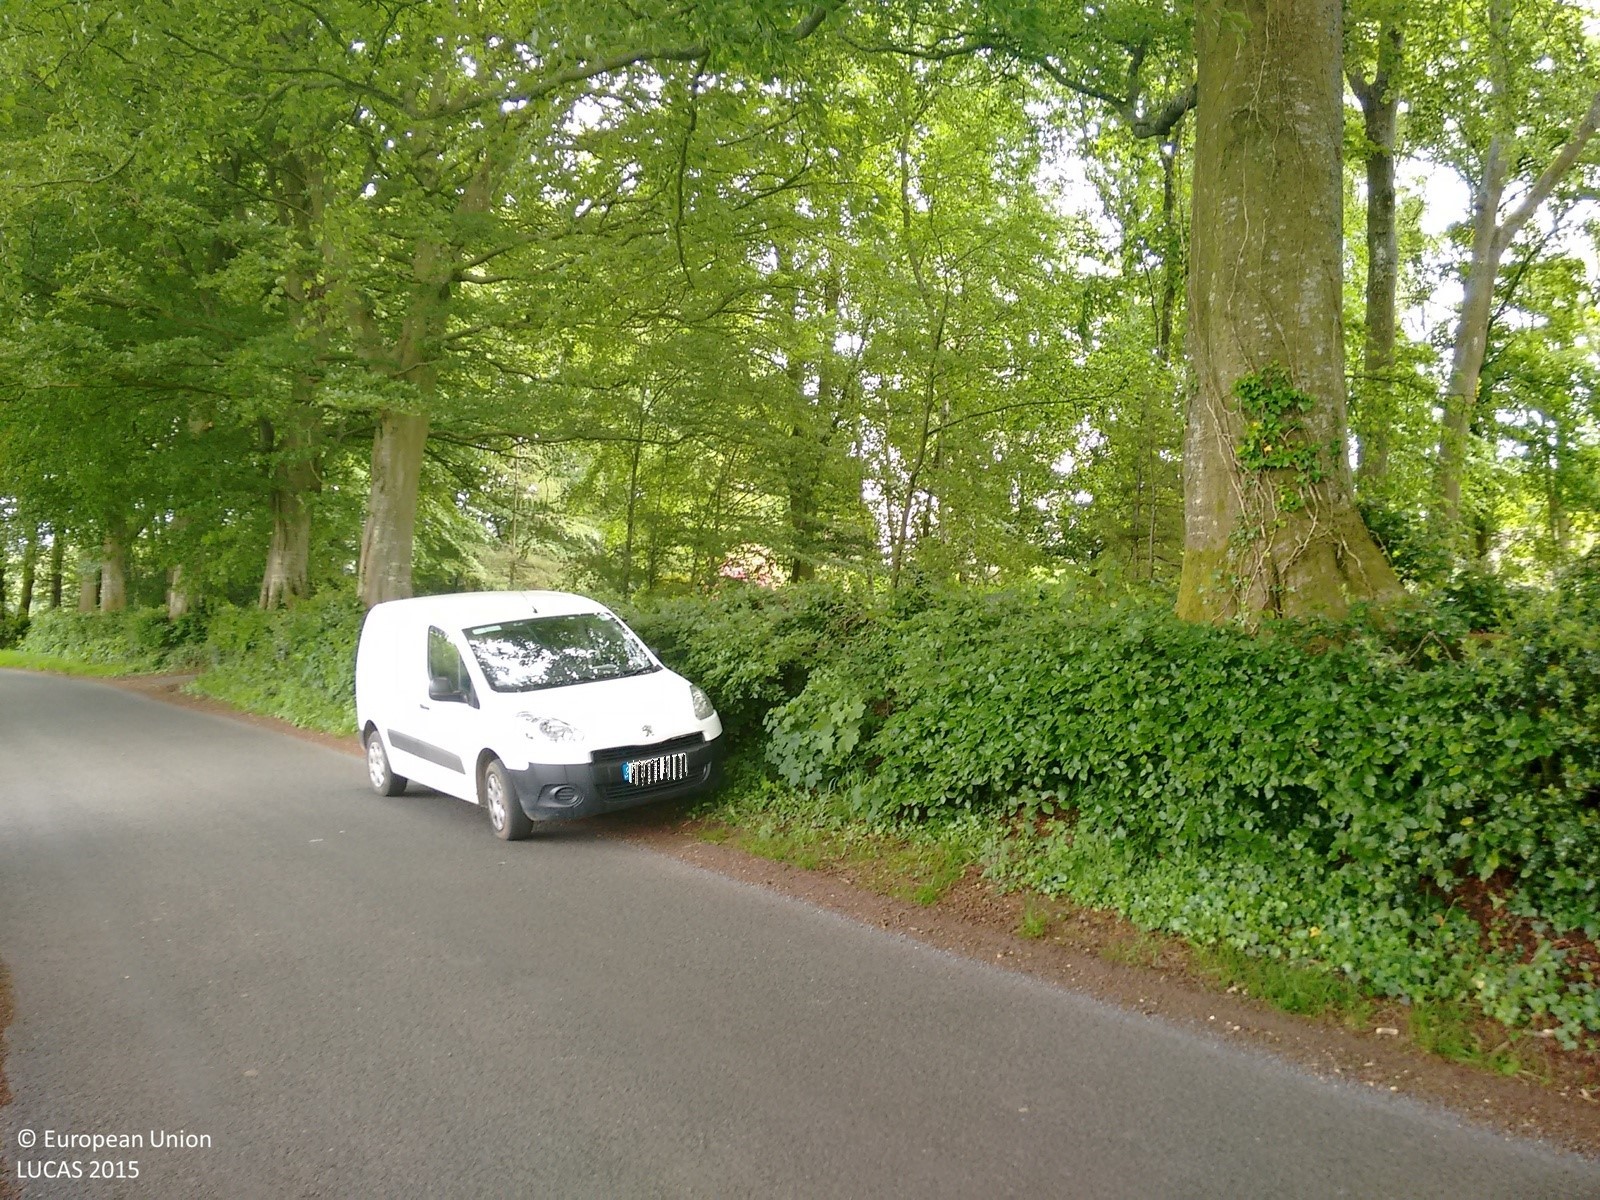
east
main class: Woodland
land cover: Broadleaved woodland
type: beech forest
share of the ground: > 75 %
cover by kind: broadleaved forest trees 90 %, herbaceous plants 10 %
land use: Semi-natural and natural areas not in use
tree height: > 5 m
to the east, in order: Broadleaved woodland; Managed hedges; Paved roads, cycling and walking lanes; Grass margins; Broadleaved woodland; Fences; Broadleaved woodland; Managed hedges; Grassland without tree/shrub cover
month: June
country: GB
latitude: 51.1038
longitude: -3.2326
